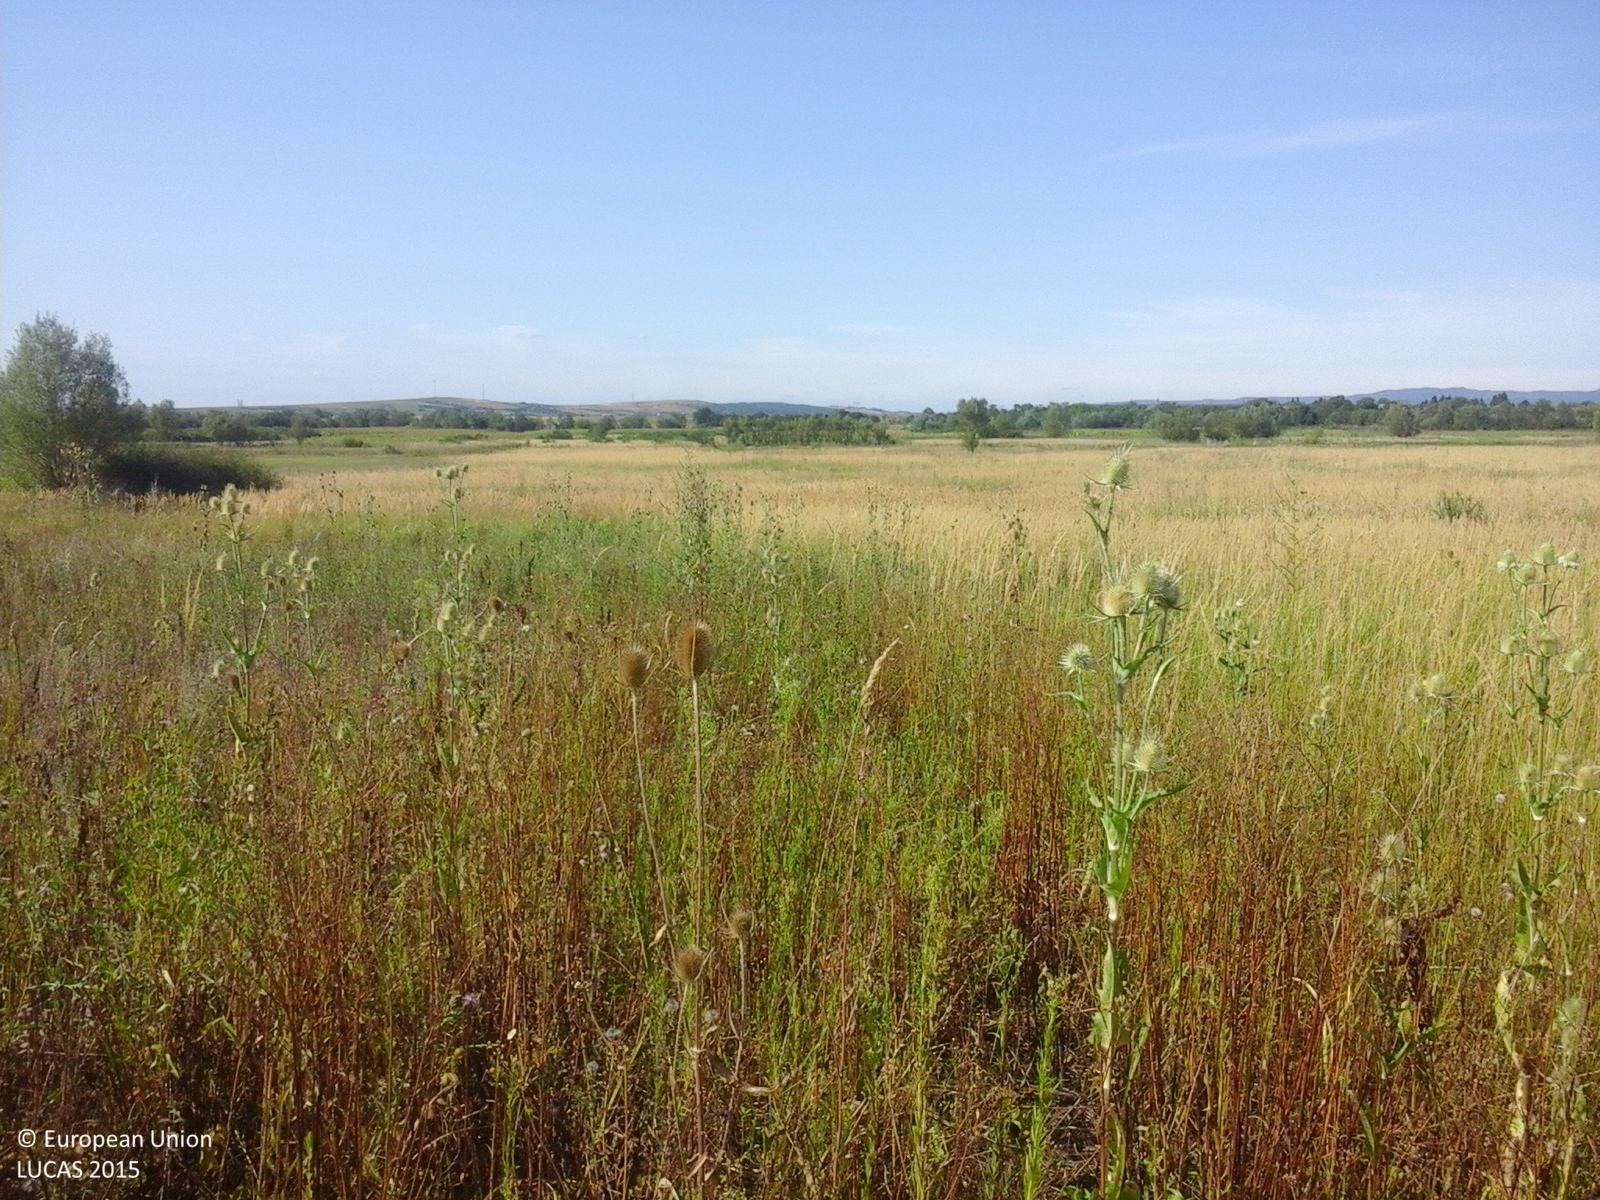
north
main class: Grassland
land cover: Spontaneously vegetated surfaces
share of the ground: > 75 %
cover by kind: herbaceous plants 100 %
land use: Fallow land
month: August
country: RO
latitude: 45.0806
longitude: 21.6040
